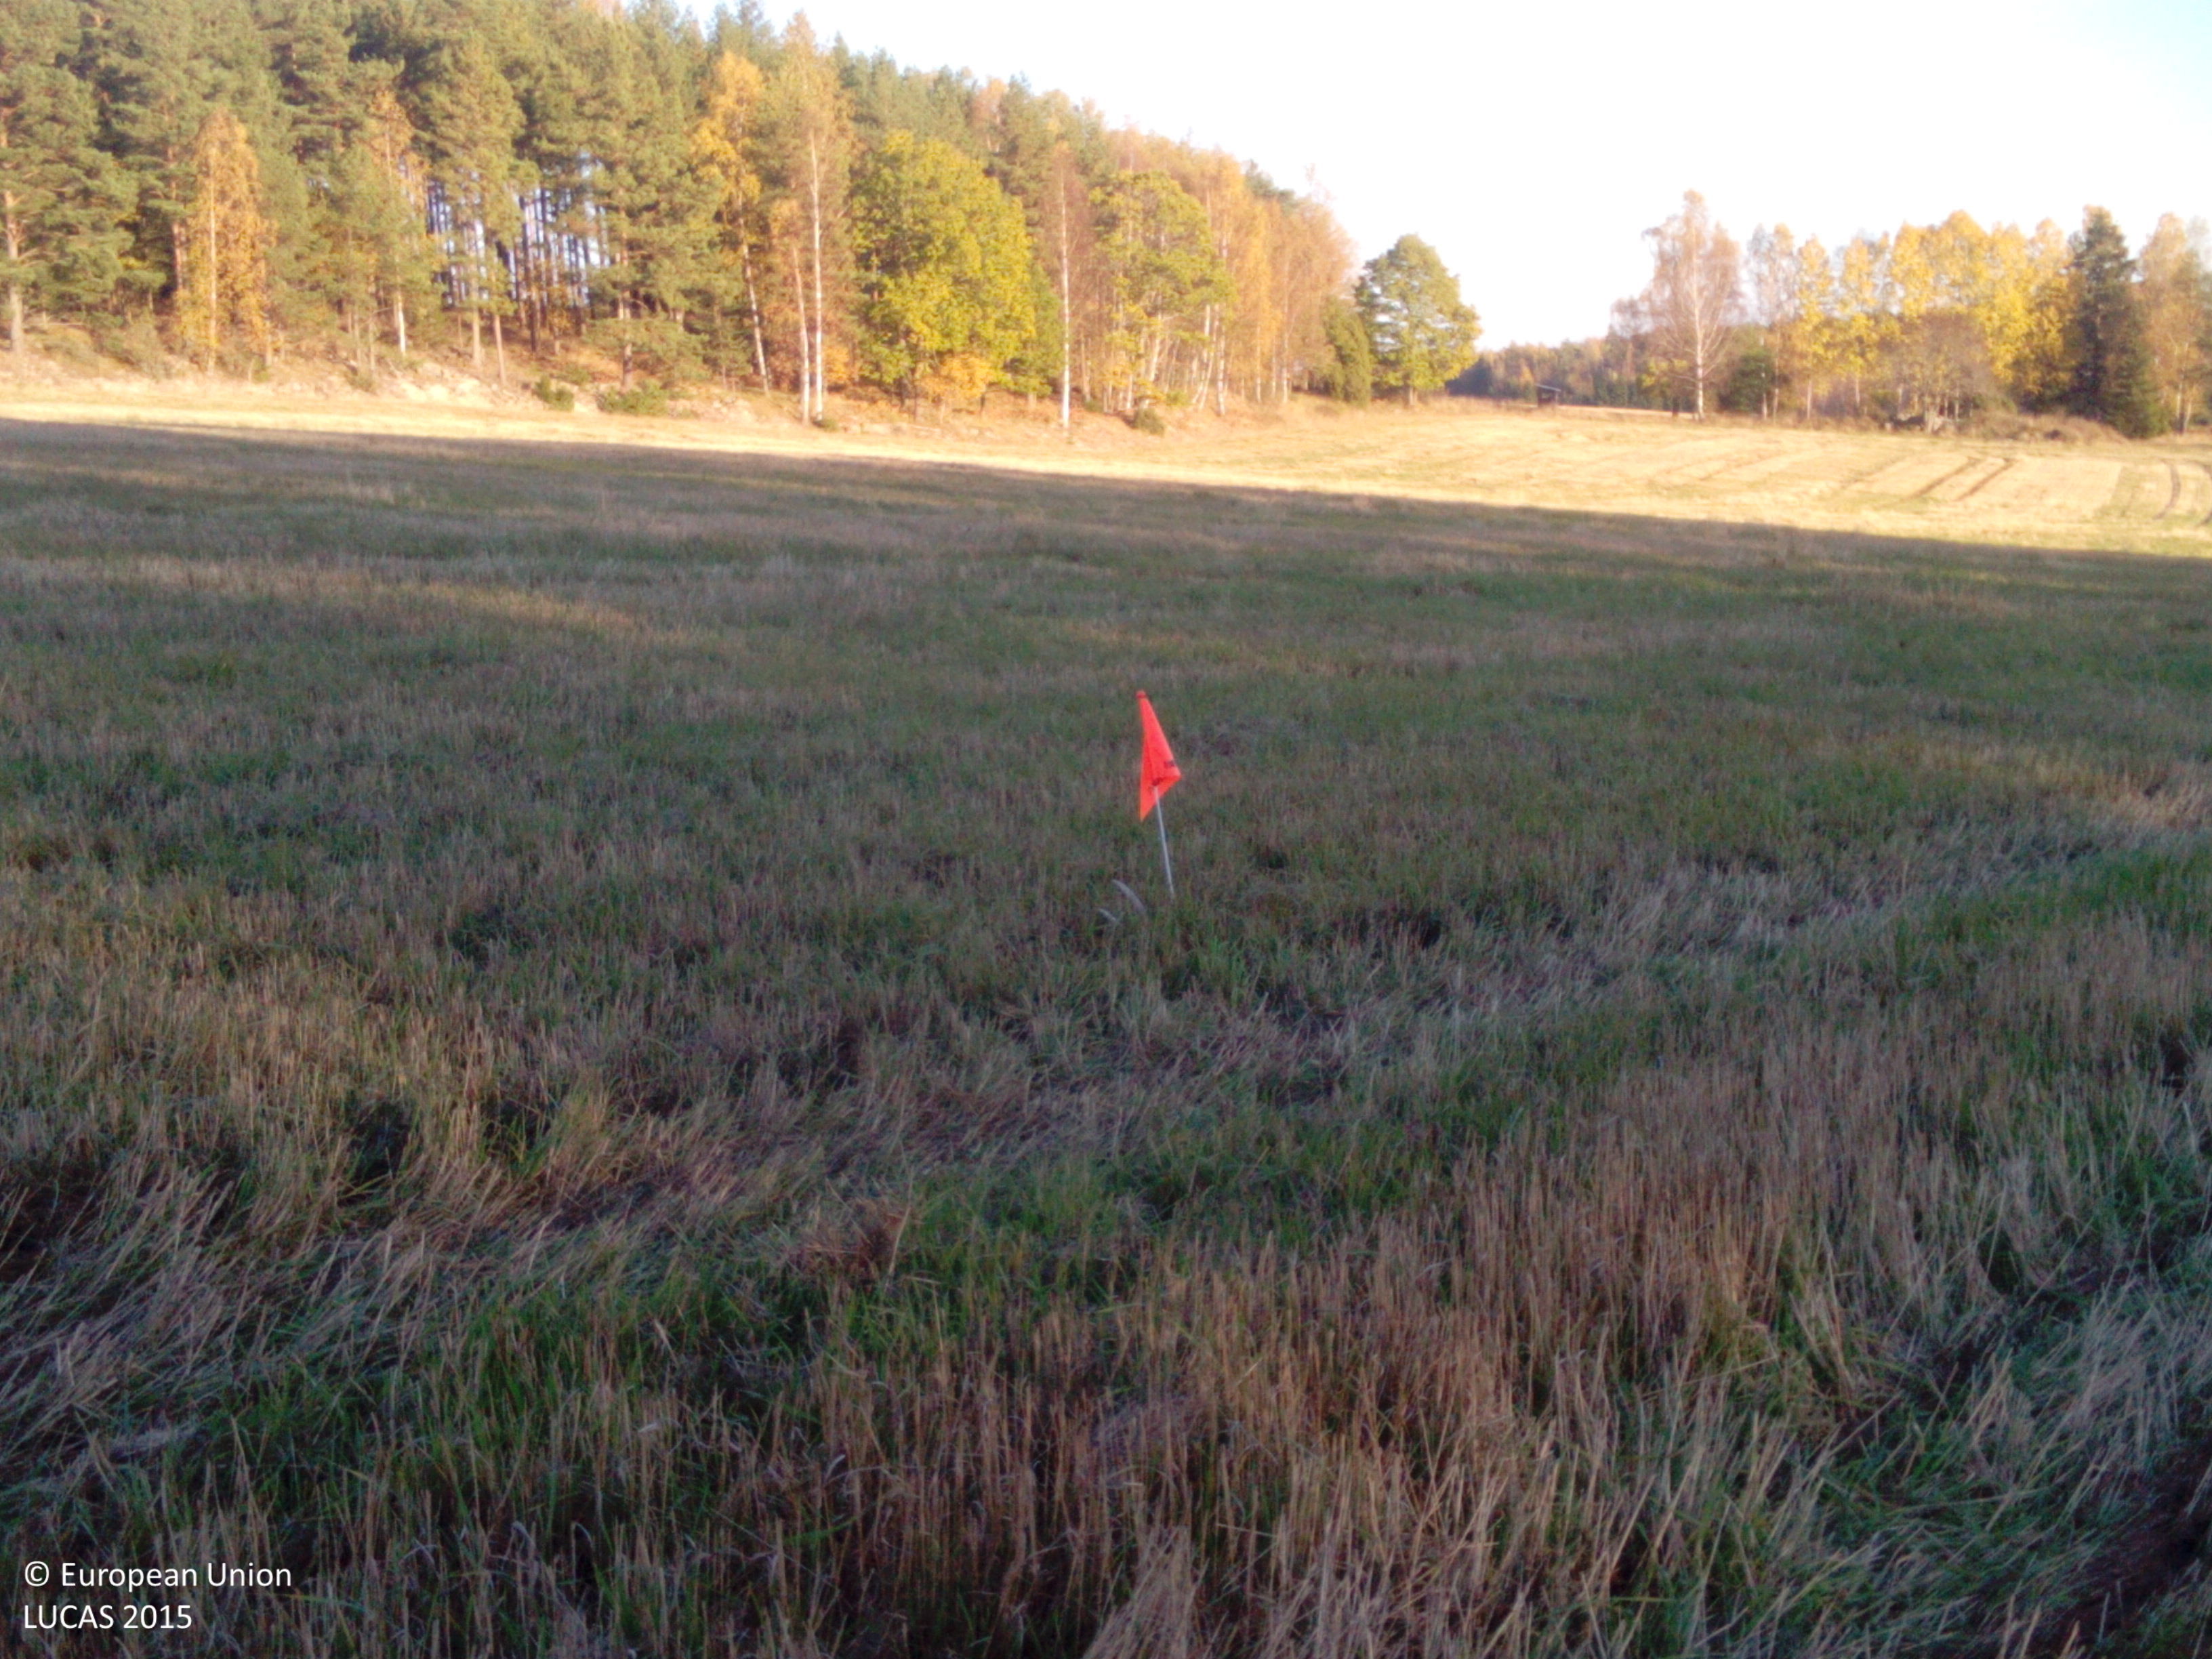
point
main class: Grassland
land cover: Grassland without tree/shrub cover
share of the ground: > 75 %
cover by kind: herbaceous plants 100 %
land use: Agriculture (excluding fallow land and kitchen gardens)
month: October
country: SE
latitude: 58.7736
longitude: 16.7231
